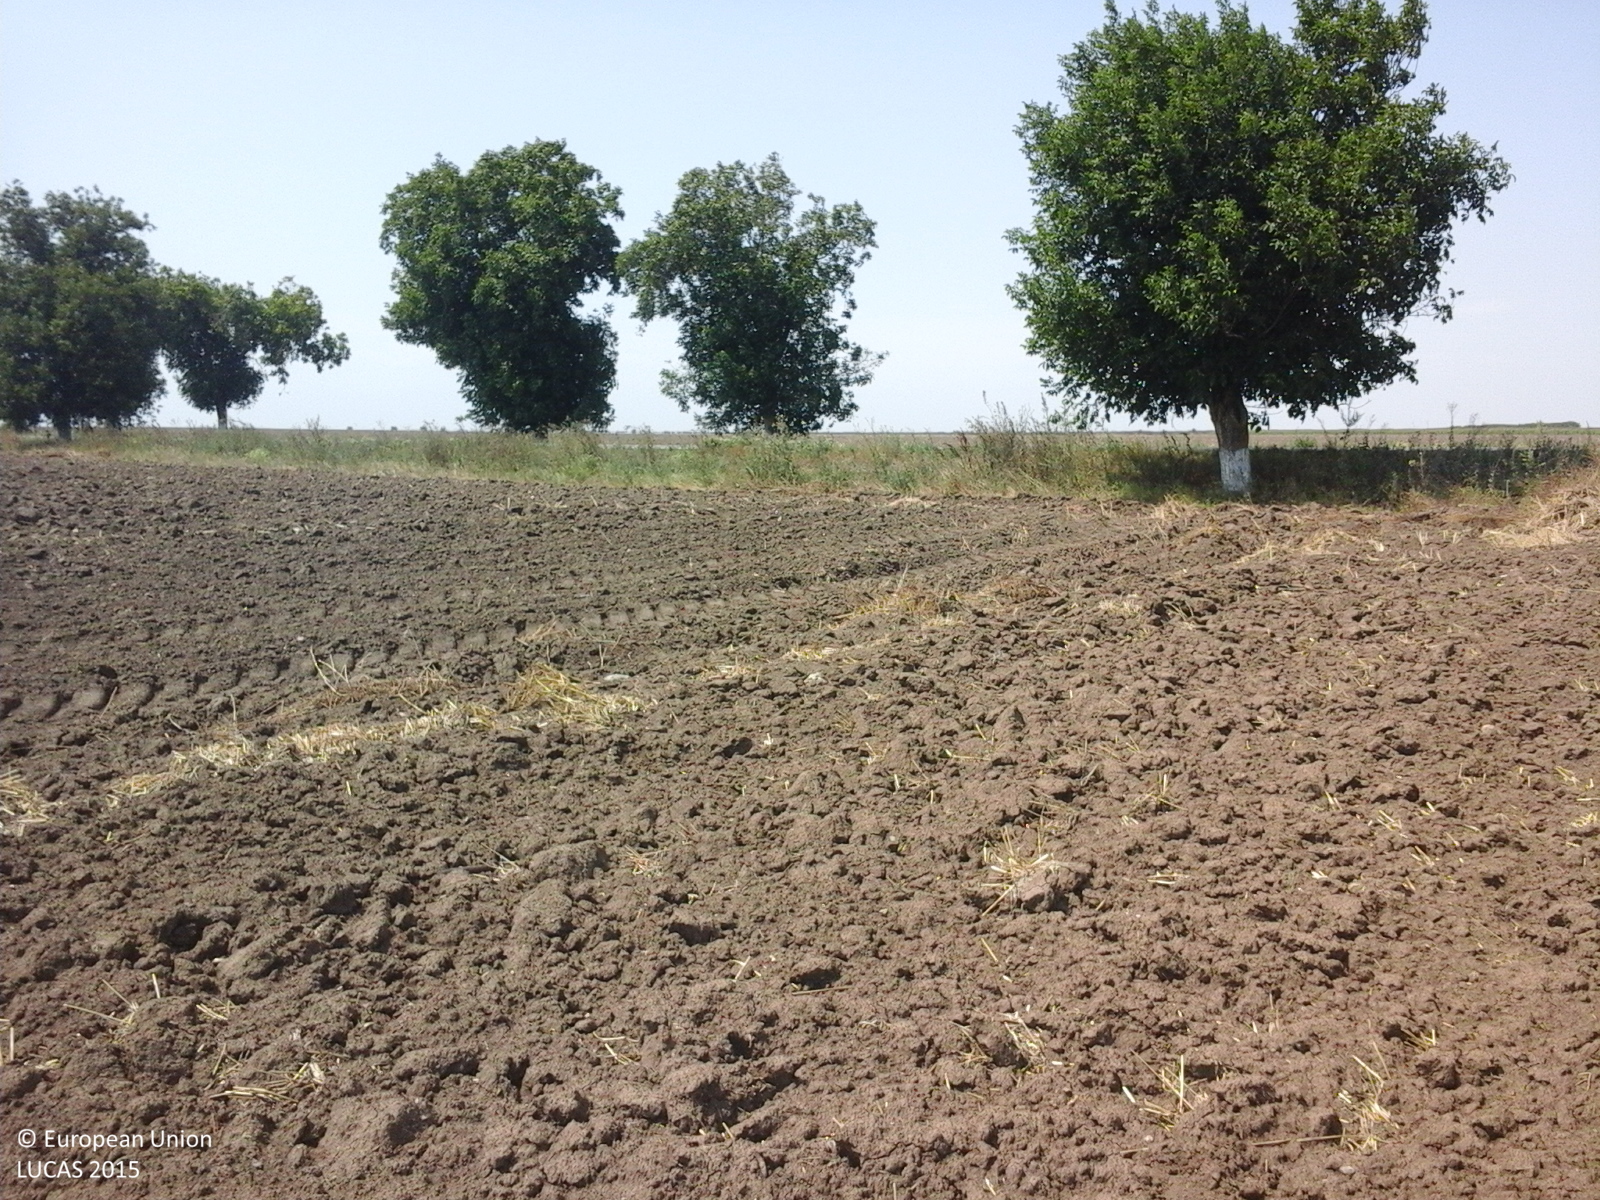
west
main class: Cropland
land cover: Common wheat
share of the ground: < 10 %
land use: Agriculture (excluding fallow land and kitchen gardens)
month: August
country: RO
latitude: 43.9317
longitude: 28.3613
